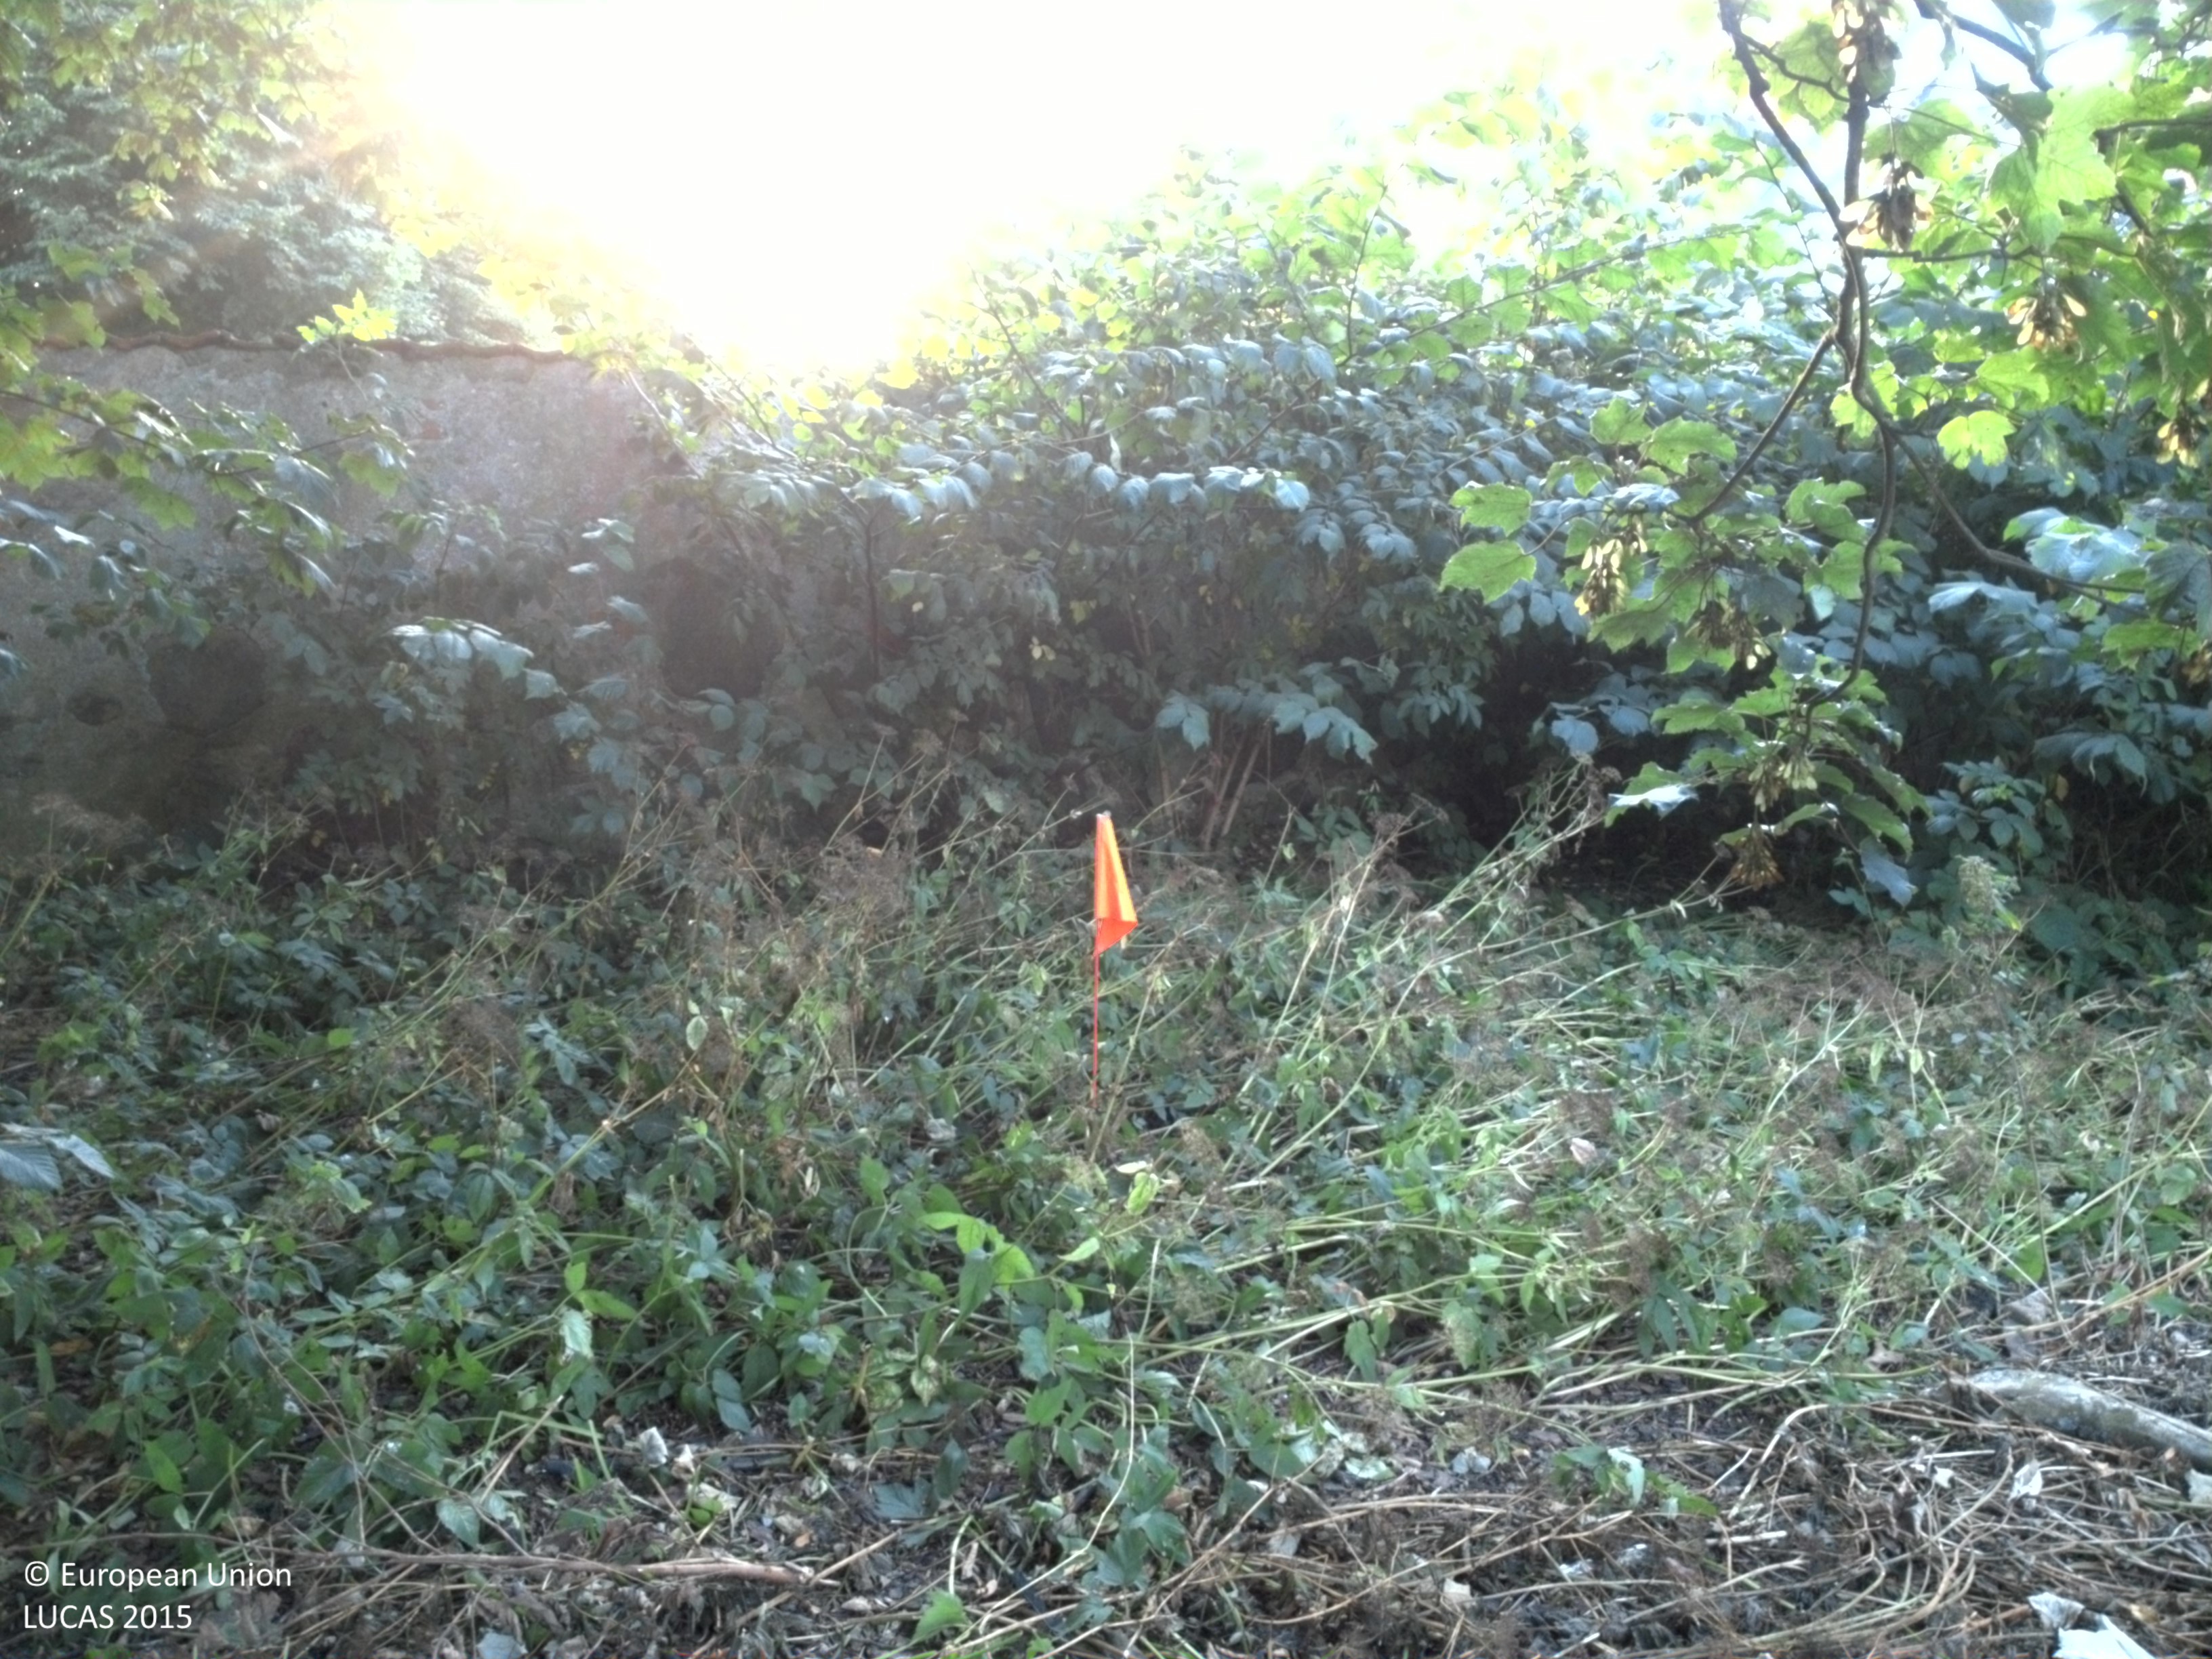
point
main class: Shrubland
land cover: Shrubland with sparse tree cover
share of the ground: 50 - 75 %
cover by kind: shrubs 60 %, herbaceous plants 35 %, broadleaved forest trees 5 %
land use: Residential
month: August
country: SE
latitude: 55.4350
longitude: 13.6176
